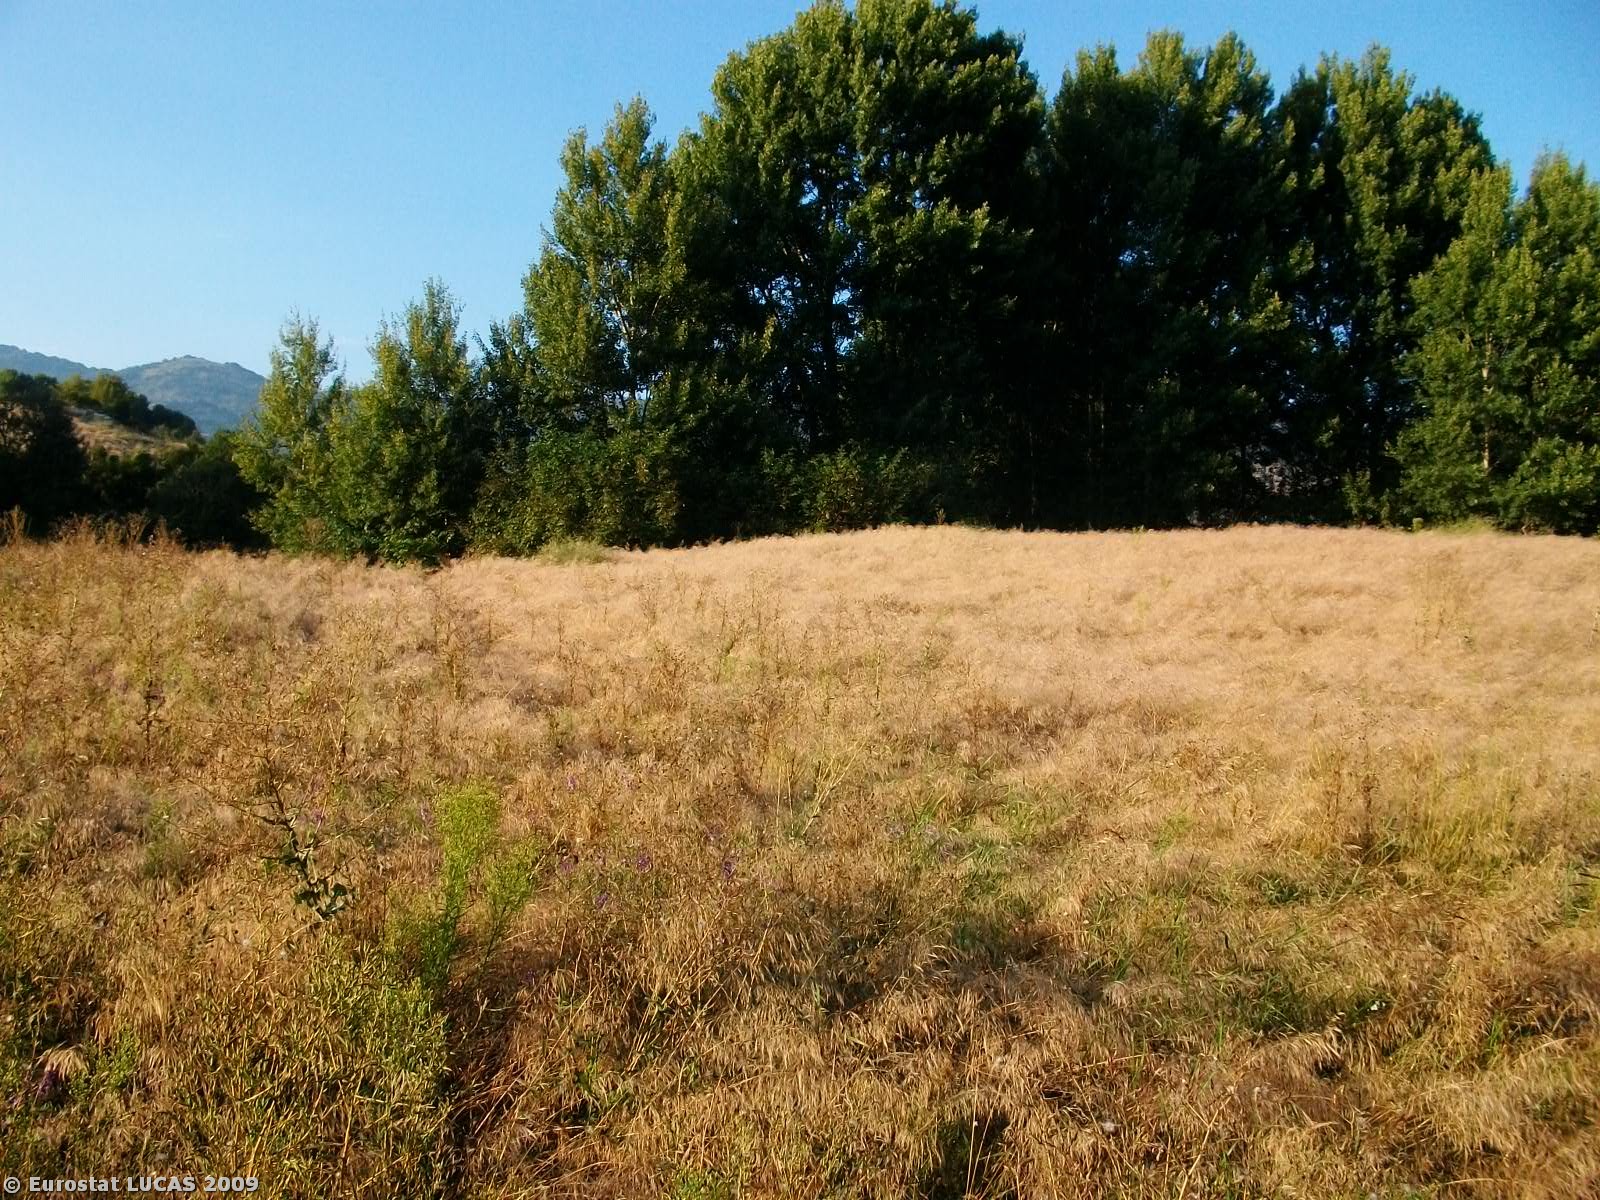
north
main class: Grassland
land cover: Grassland without tree/shrub cover
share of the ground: > 75 %
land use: Unused
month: September
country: GR
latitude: 41.2798
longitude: 23.6946
